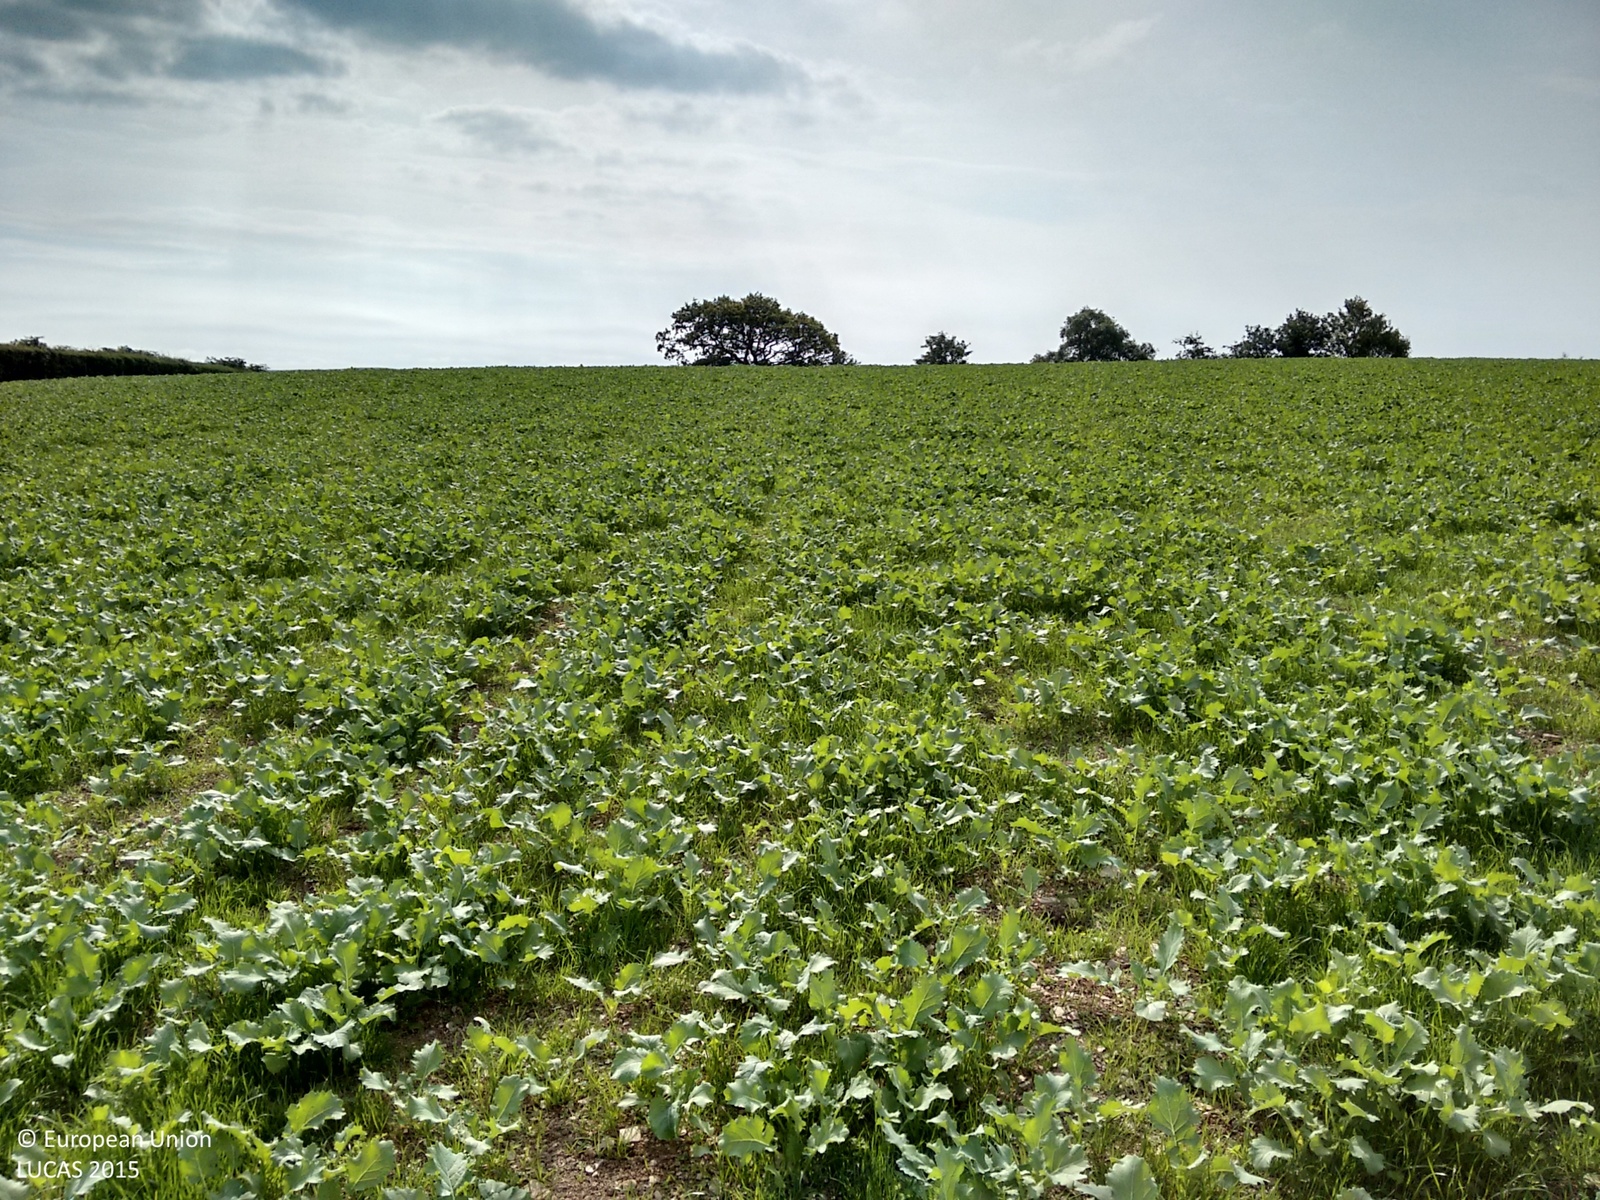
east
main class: Cropland
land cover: Sugar beet
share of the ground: > 75 %
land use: Agriculture (excluding fallow land and kitchen gardens)
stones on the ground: 10 - 25 %
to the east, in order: Sugar beet; Fences; Managed hedges; Fences; Sugar beet; Fences; Managed hedges; Grassland without tree/shrub cover; Abandoned hedges; Grassland without tree/shrub cover
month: August
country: GB
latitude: 52.0158
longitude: -4.0101
